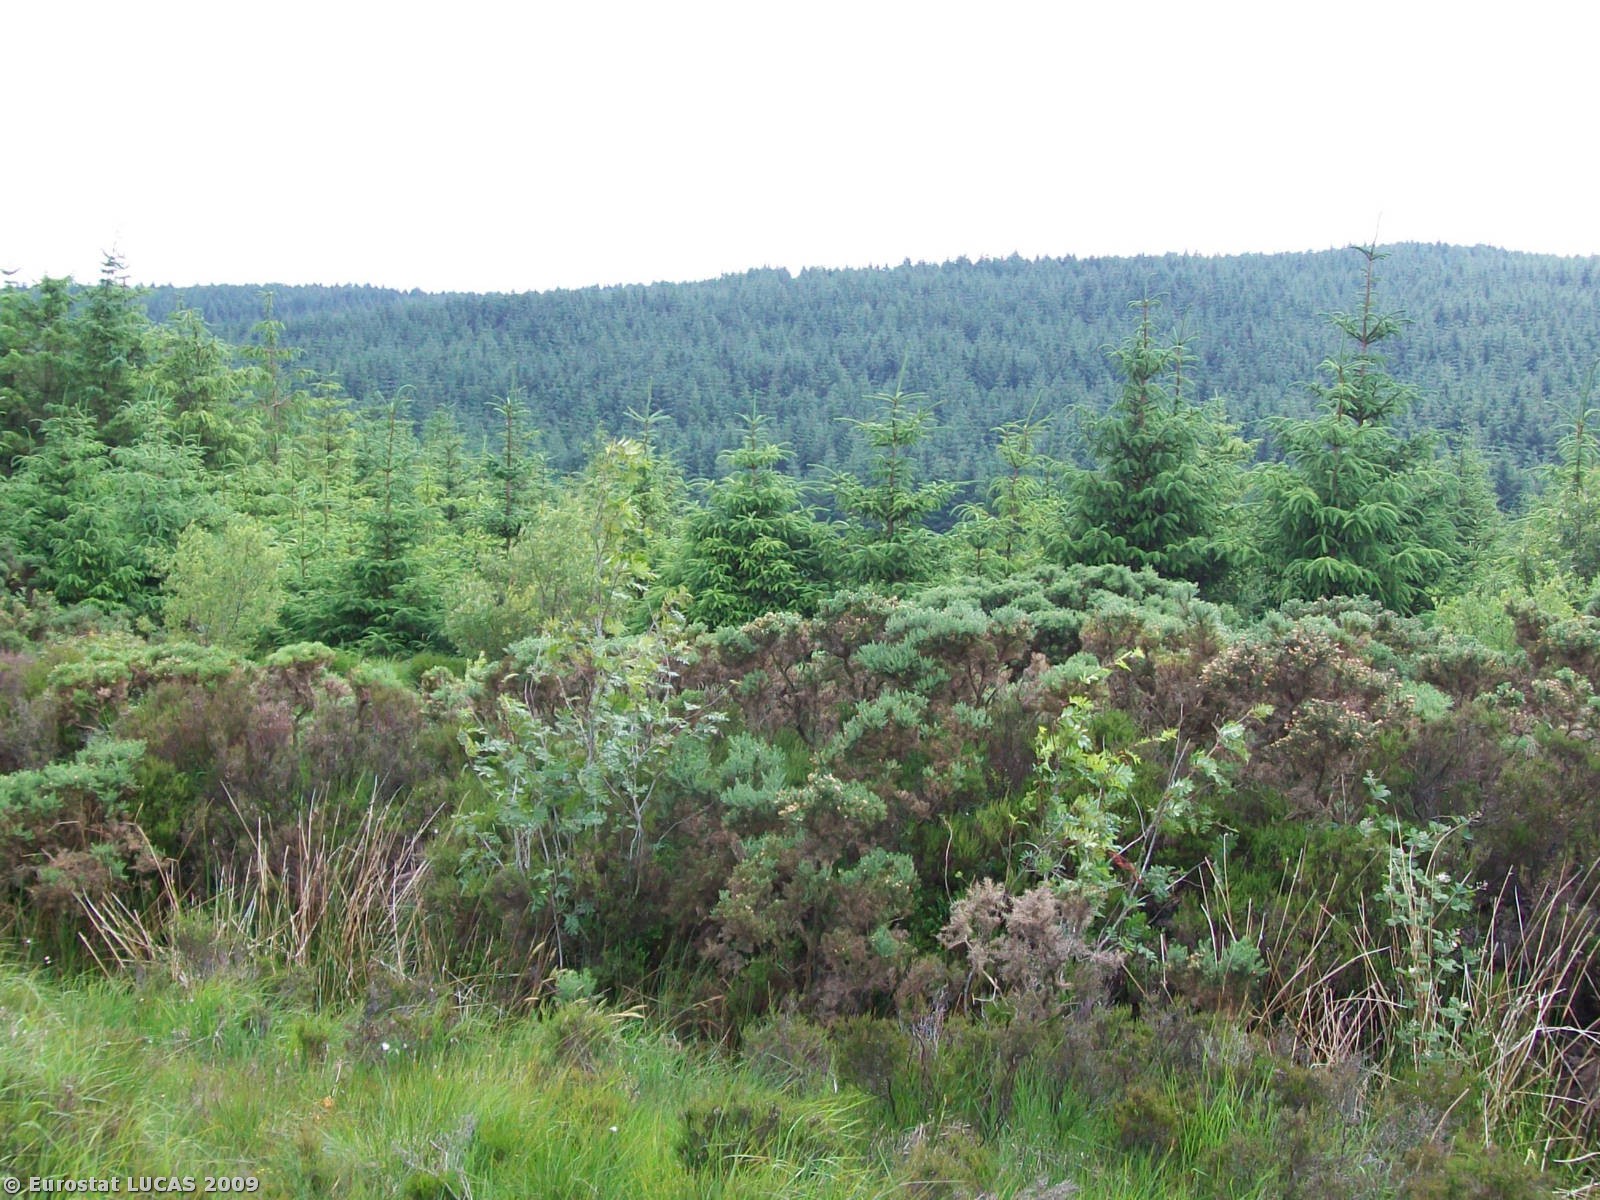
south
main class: Shrubland
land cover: Shrubland without tree cover
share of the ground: > 75 %
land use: Agriculture (excluding fallow land and kitchen gardens)
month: June
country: GB
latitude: 54.2874
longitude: -7.2456
